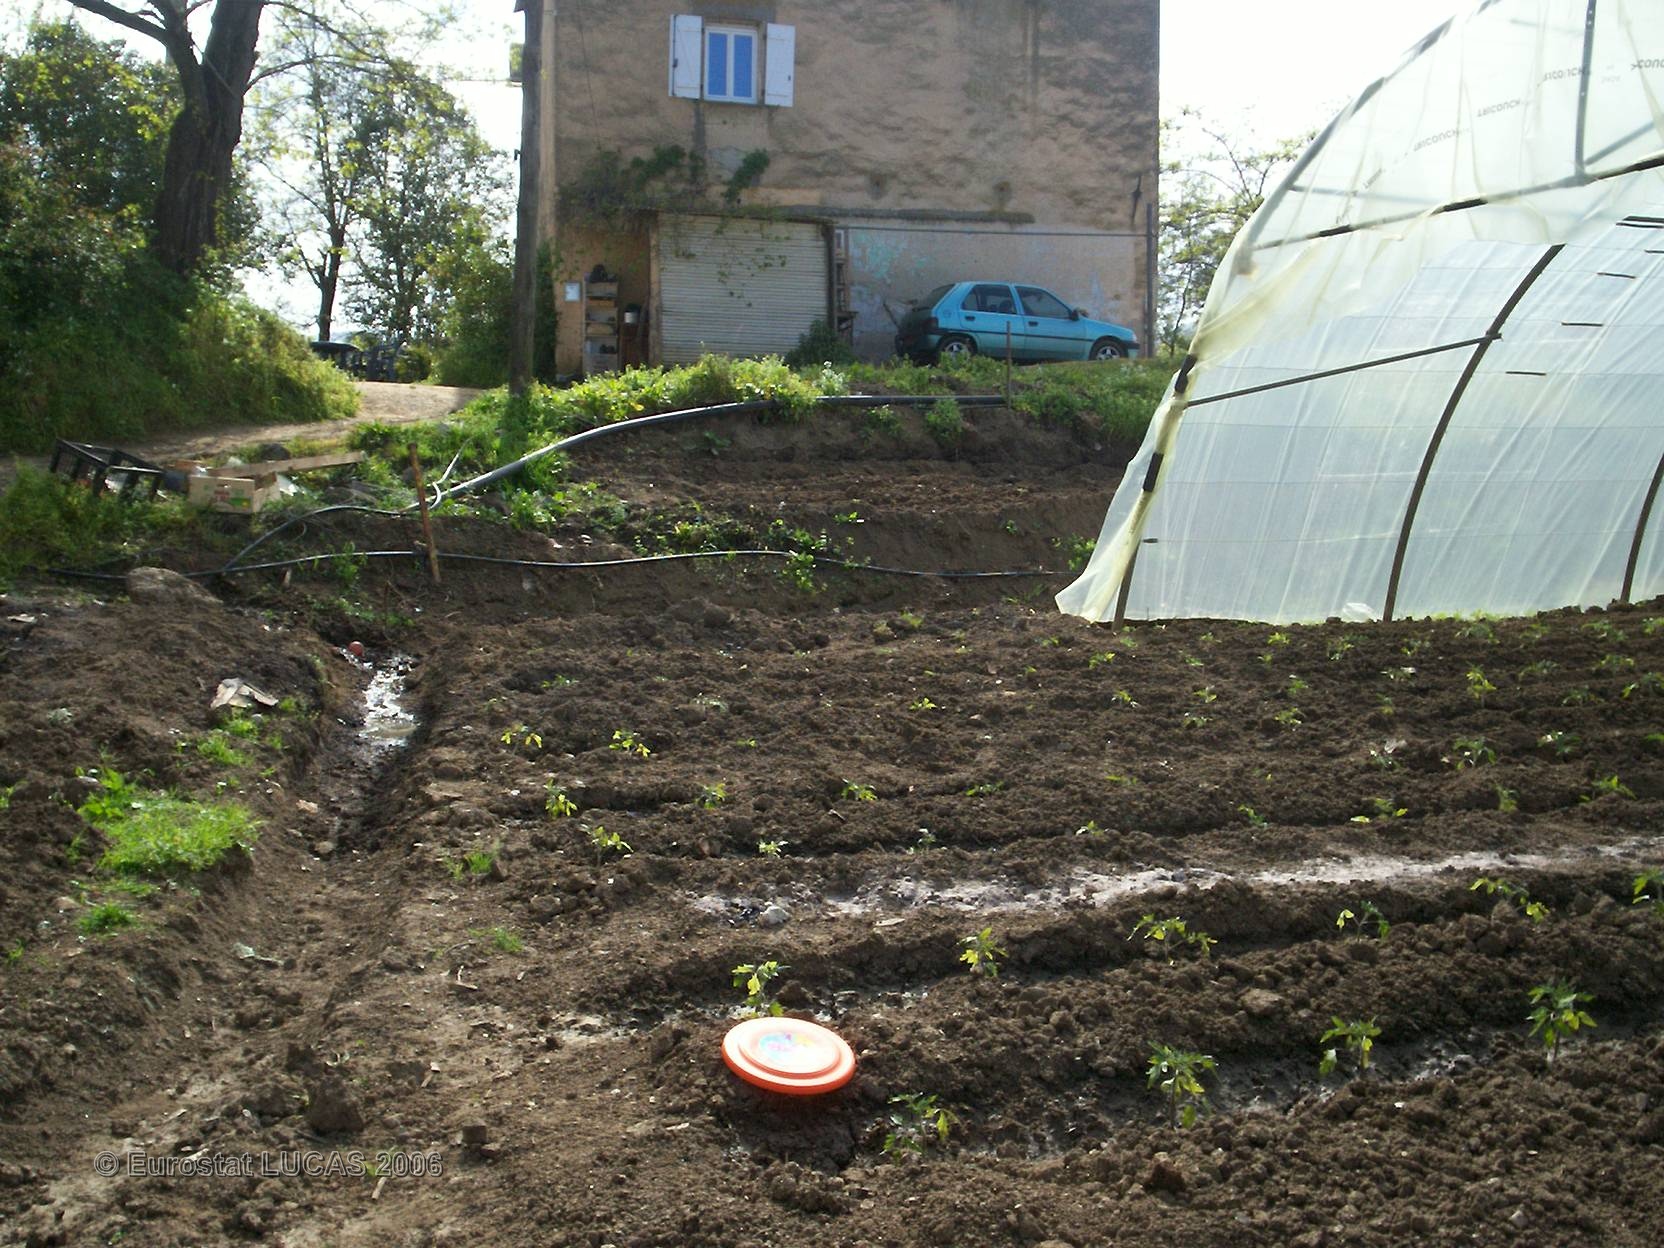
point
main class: Cropland
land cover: Tomatoes
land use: Agriculture (excluding fallow land and kitchen gardens)
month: April
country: FR
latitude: 41.9415
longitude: 8.7384
